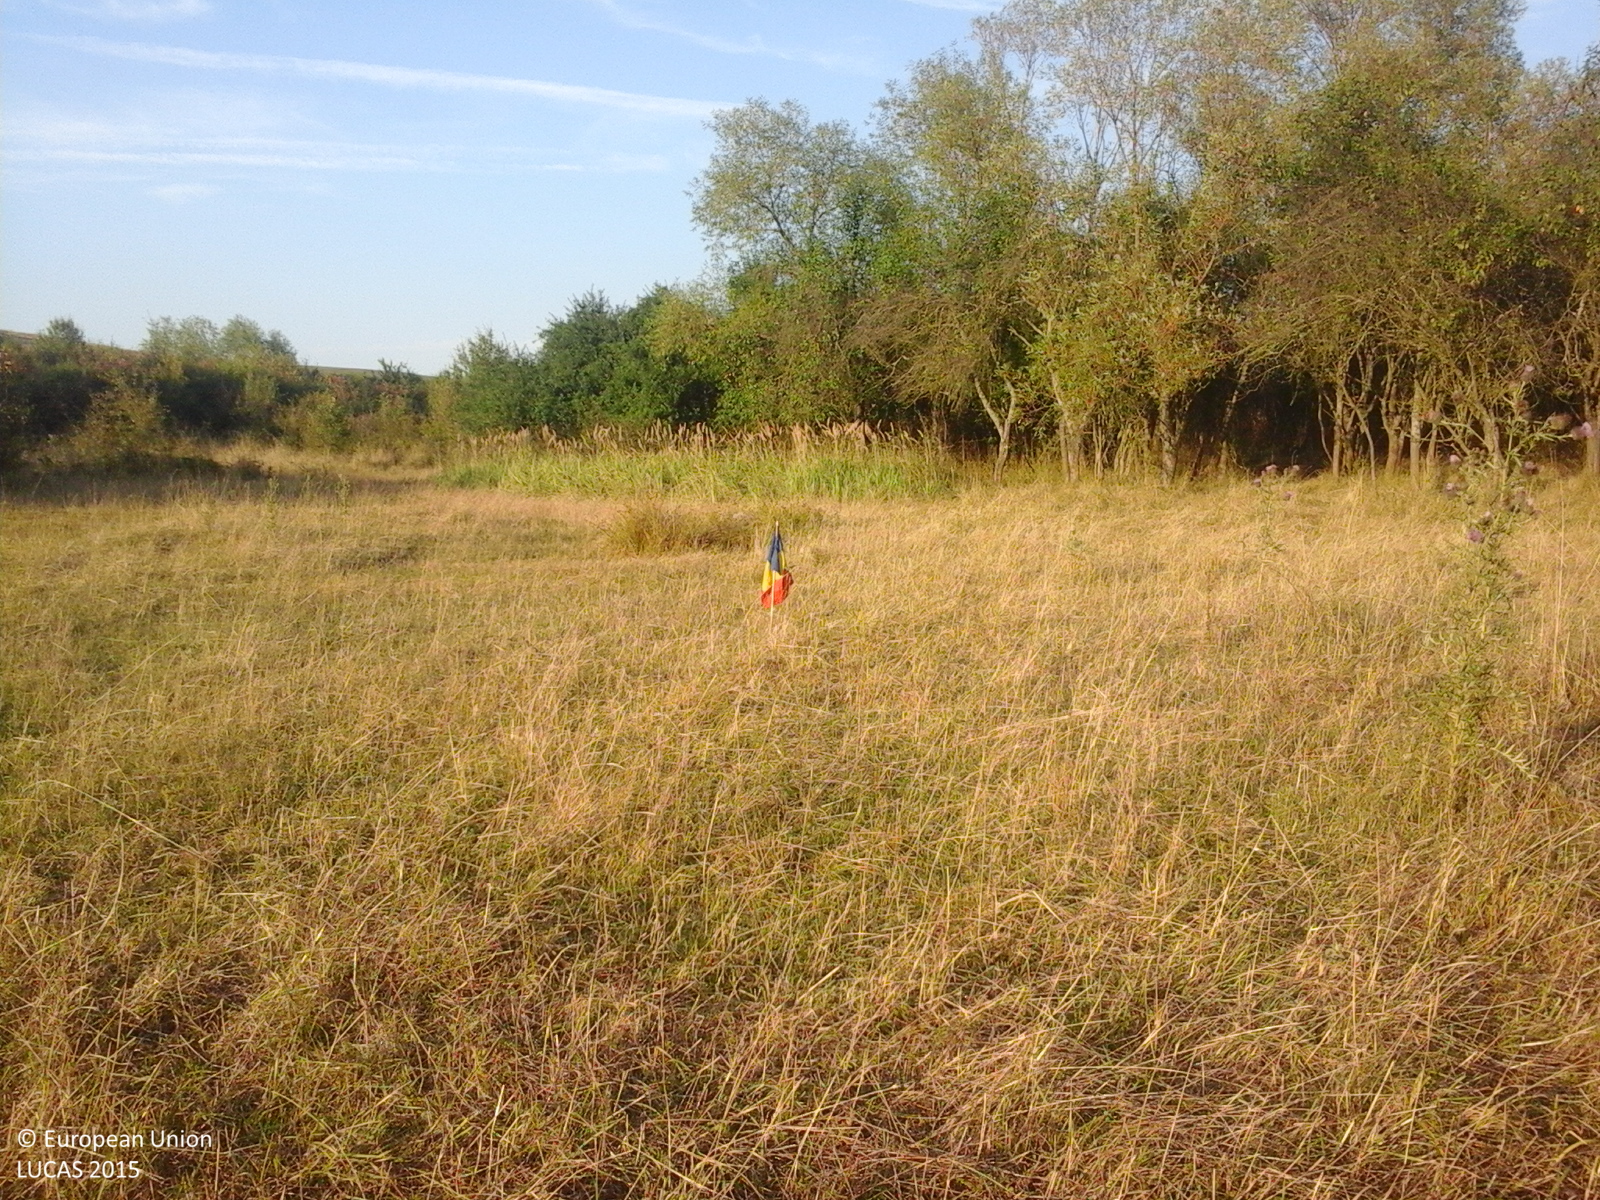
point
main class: Grassland
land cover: Grassland without tree/shrub cover
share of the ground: > 75 %
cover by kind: herbaceous plants 100 %
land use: Agriculture (excluding fallow land and kitchen gardens)
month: August
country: RO
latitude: 45.8822
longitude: 21.5936
